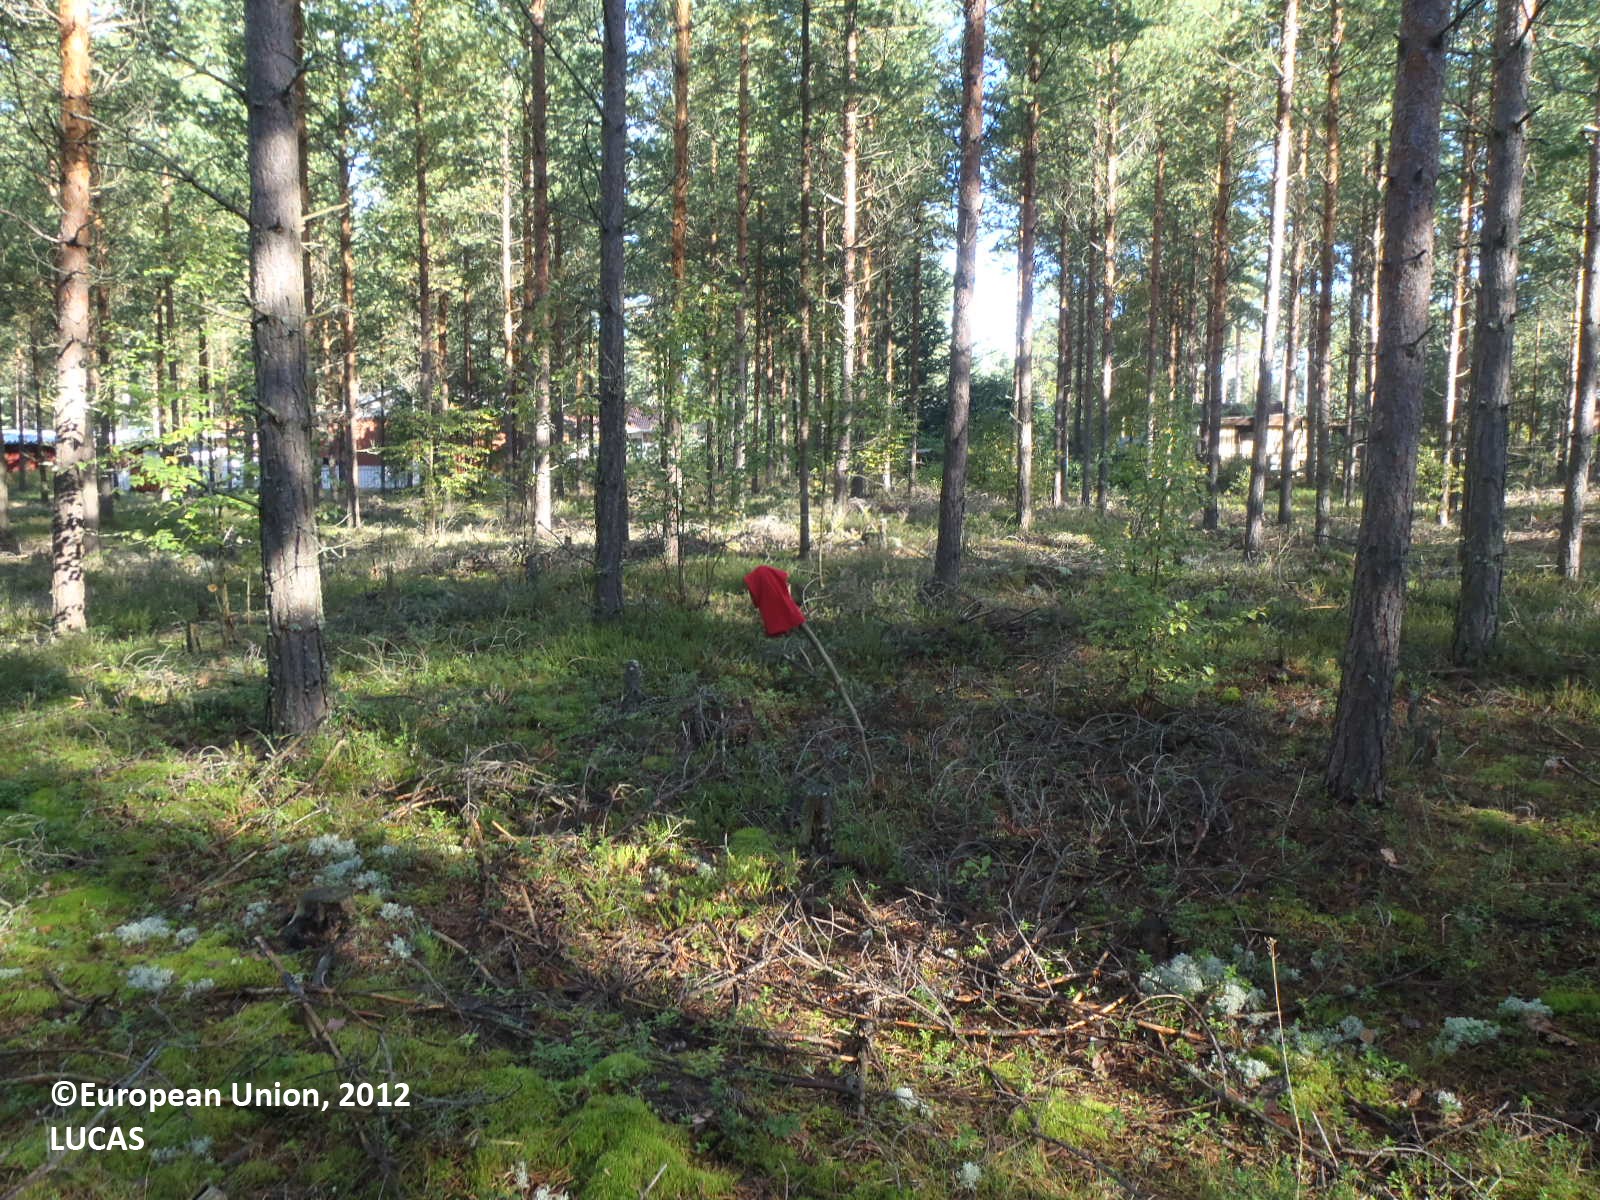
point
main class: Woodland
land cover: Pine dominated coniferous woodland
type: boreal forest
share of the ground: > 75 %
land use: Forestry
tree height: > 5 m
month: September
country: FI
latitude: 61.0746
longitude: 22.3901
